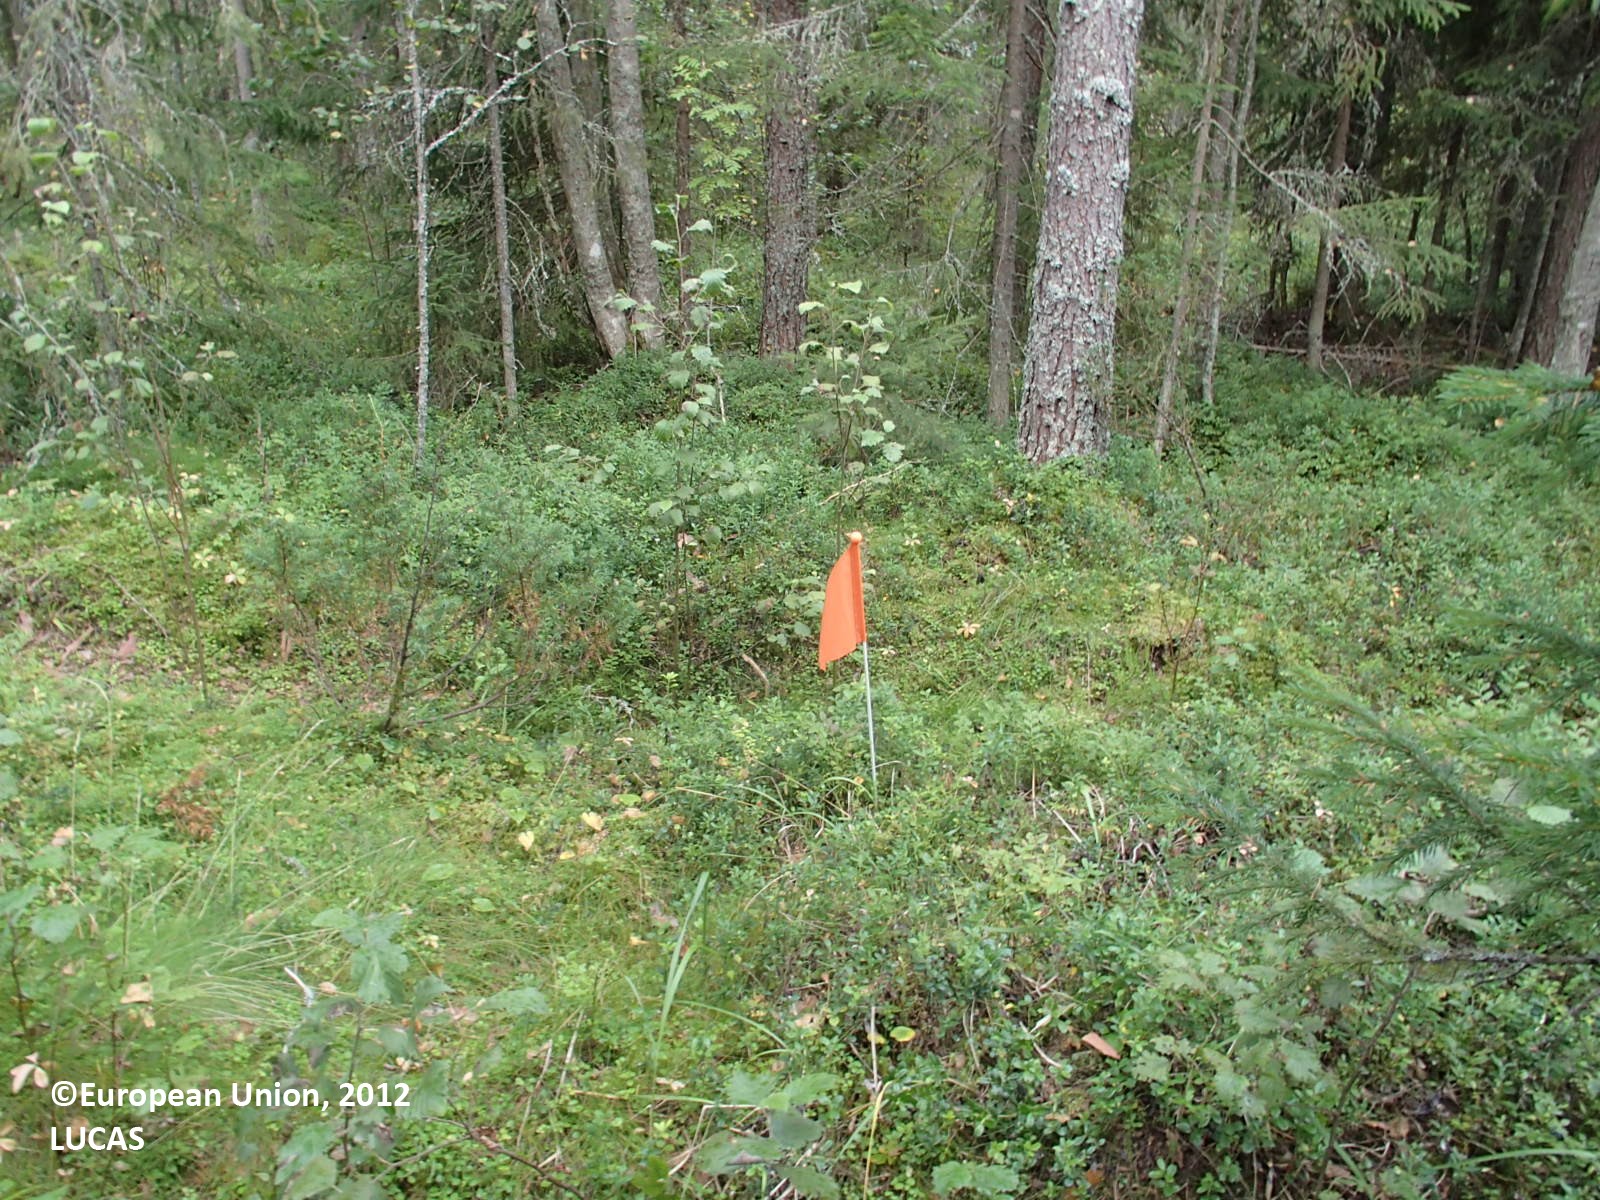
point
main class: Woodland
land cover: Other mixed woodland
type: boreal forest
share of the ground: > 75 %
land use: Forestry
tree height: > 5 m
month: August
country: FI
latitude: 63.9668
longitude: 25.6403
